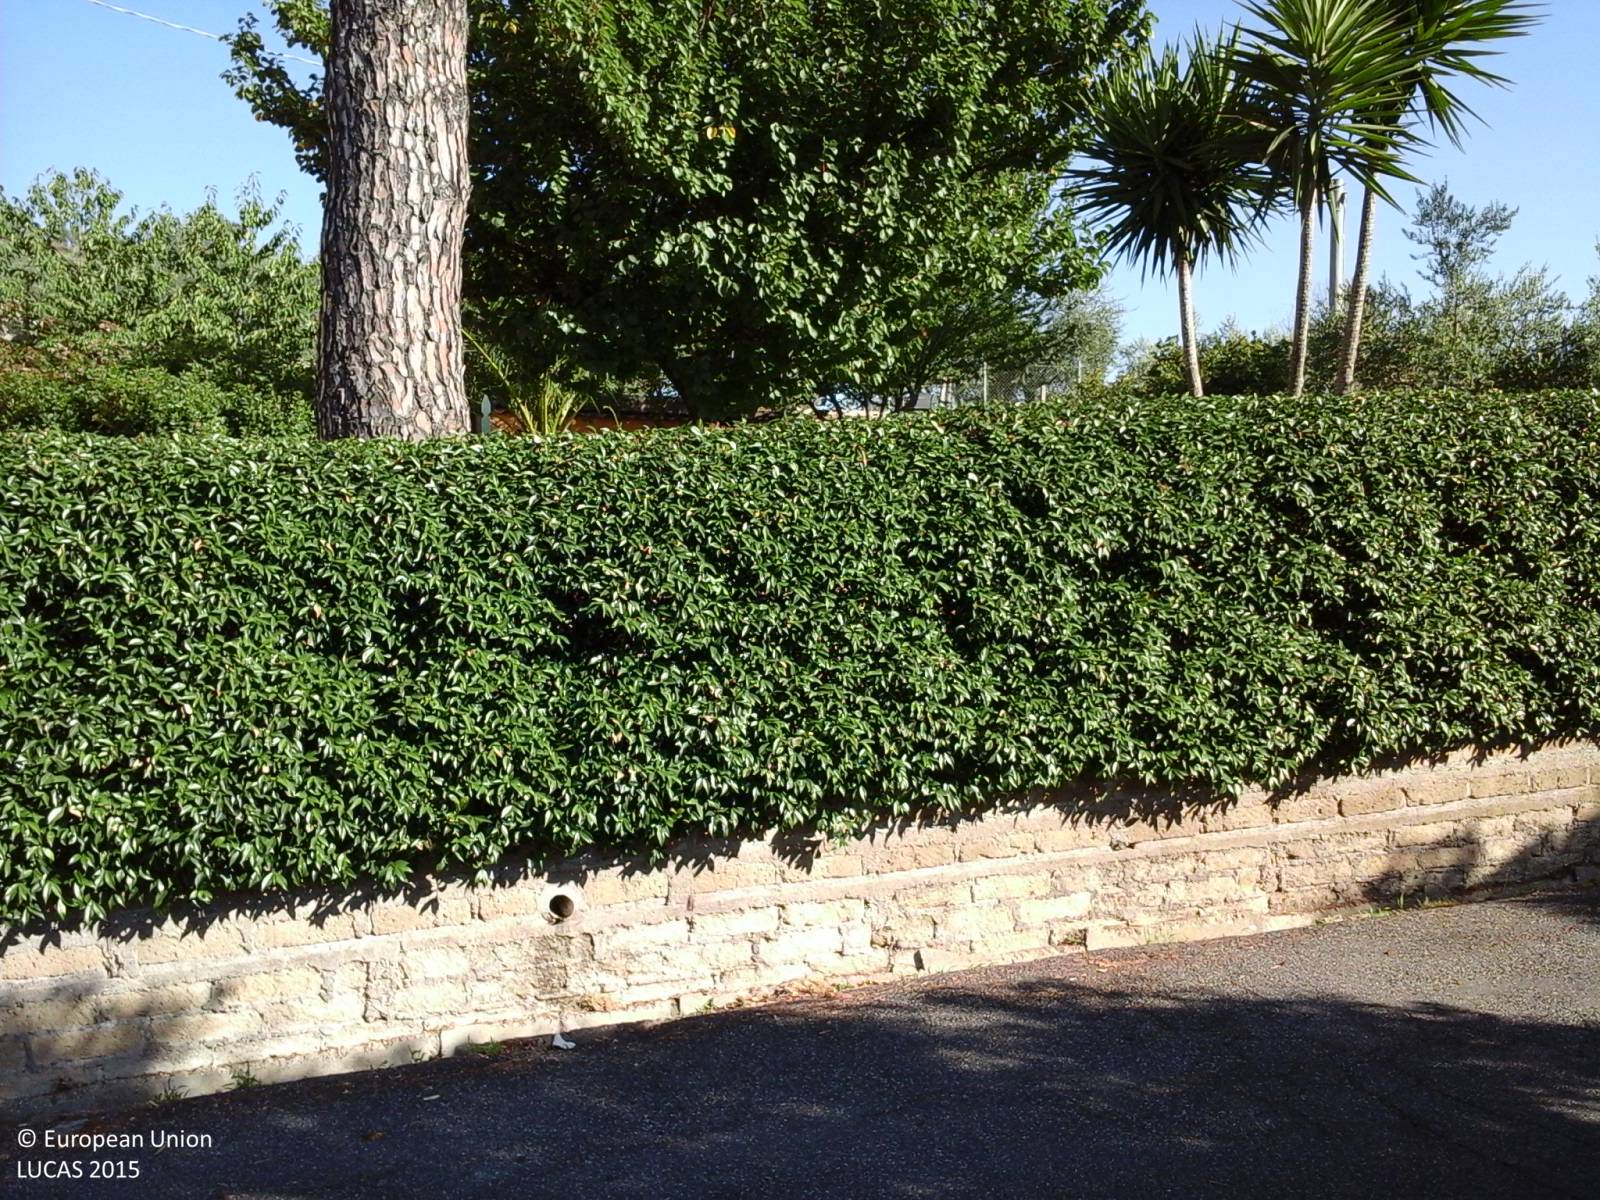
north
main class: Grassland
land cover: Grassland without tree/shrub cover
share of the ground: > 75 %
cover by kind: herbaceous plants 100 %
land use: Agriculture (excluding fallow land and kitchen gardens)
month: July
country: IT
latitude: 42.1167
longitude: 12.5188
